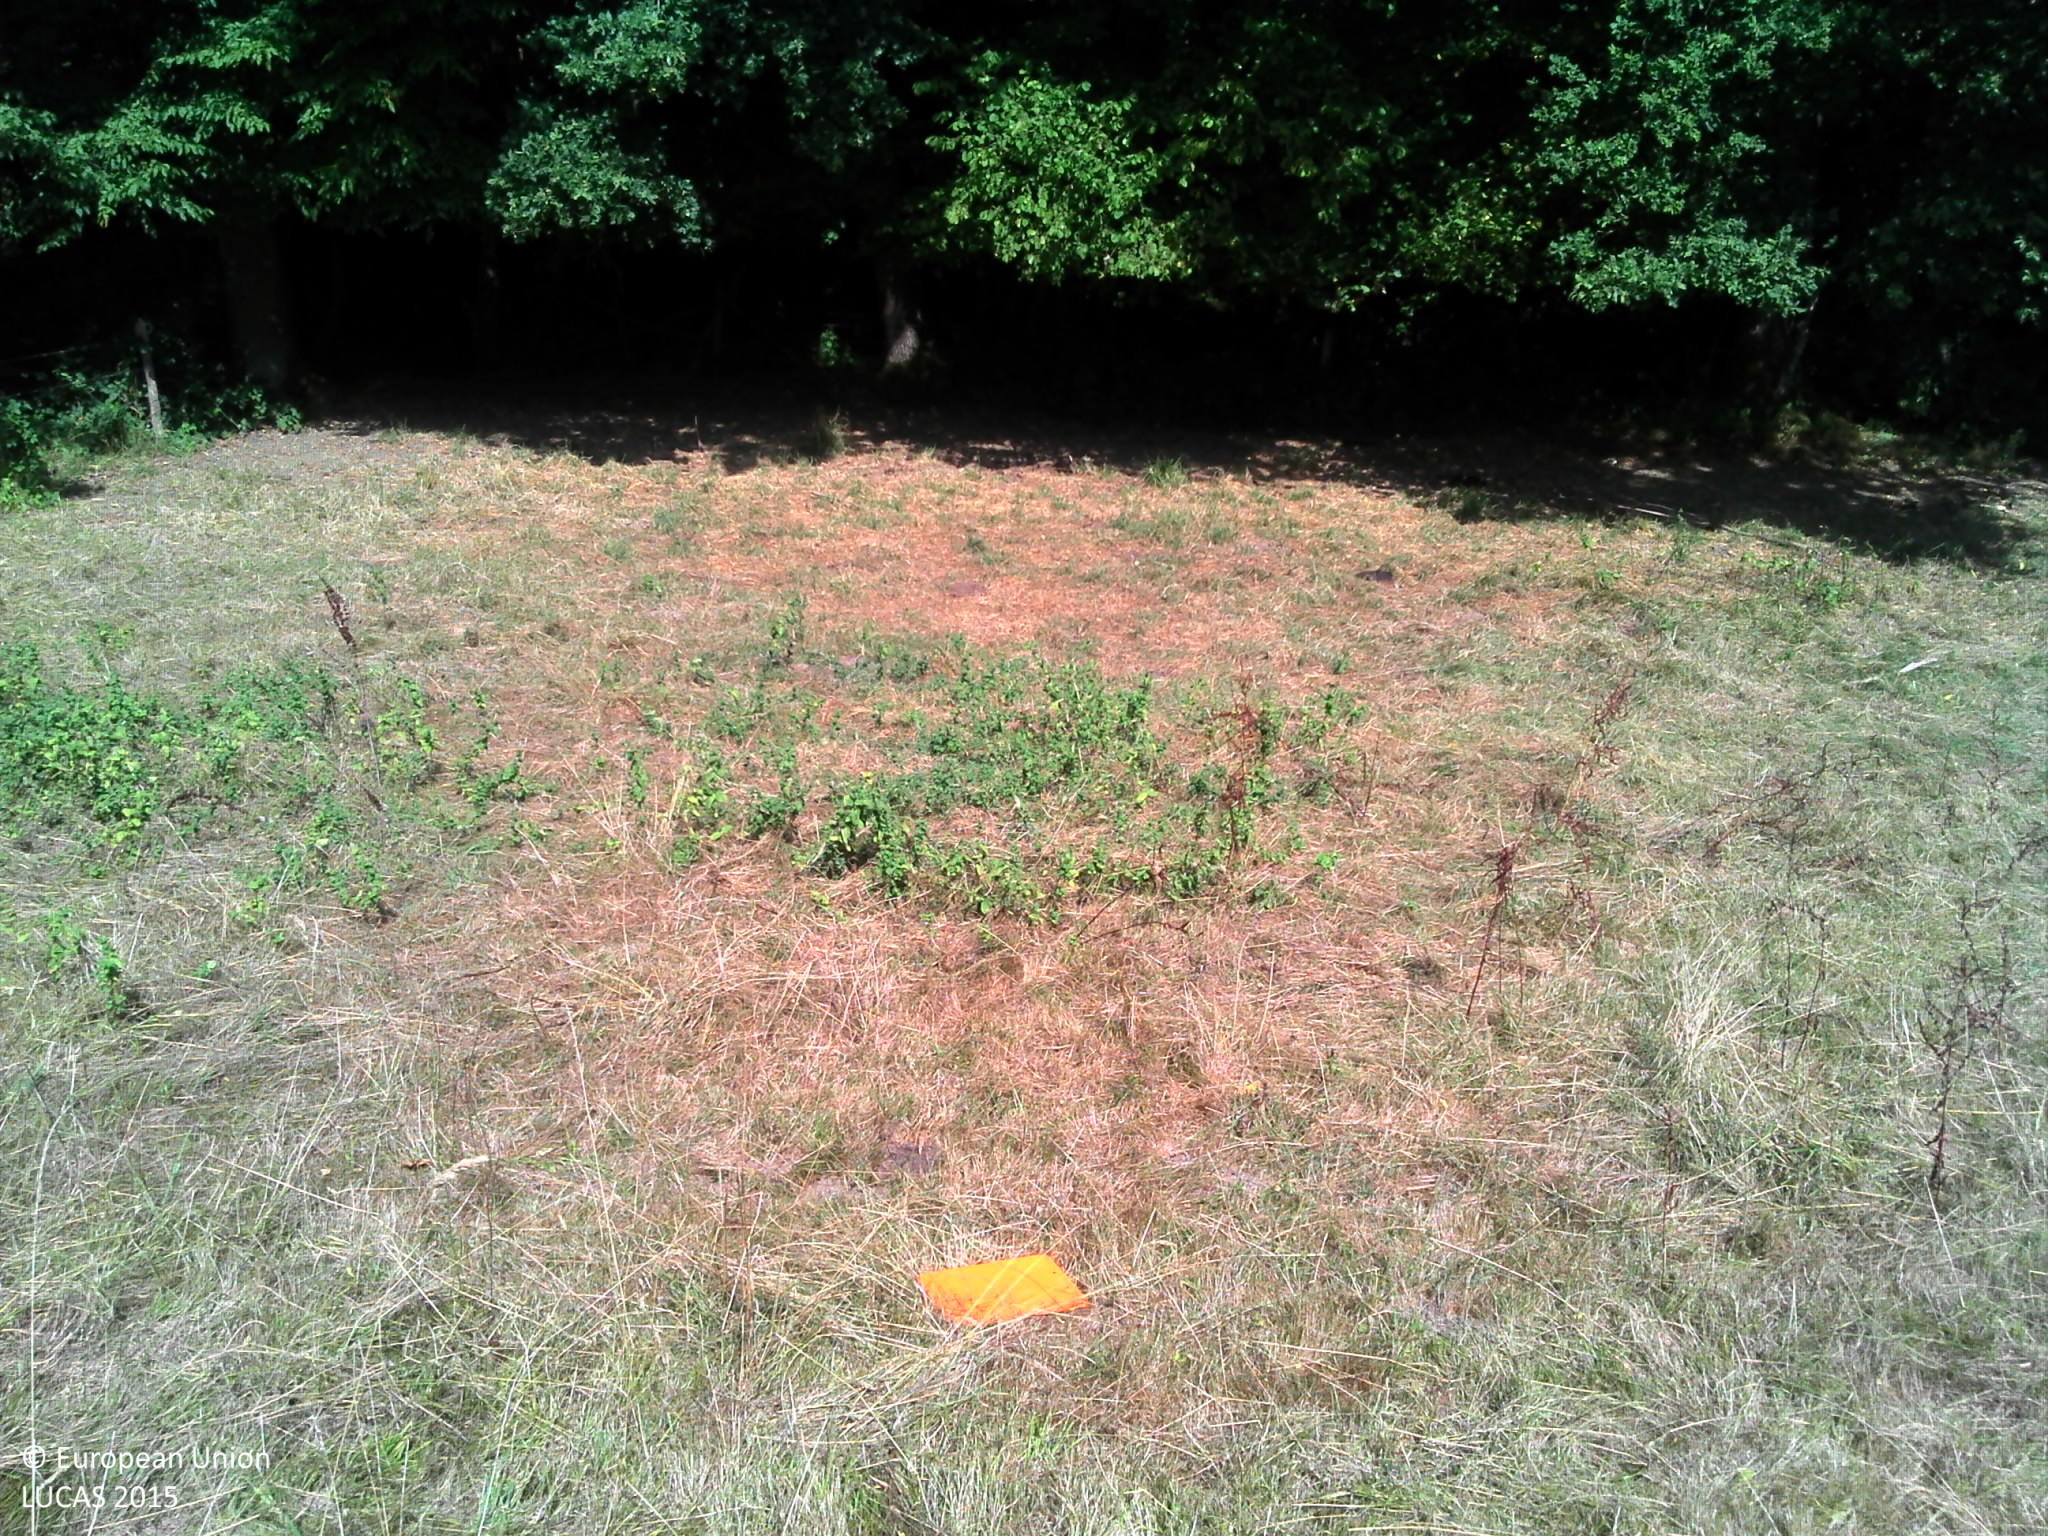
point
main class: Grassland
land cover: Grassland without tree/shrub cover
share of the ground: > 75 %
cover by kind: herbaceous plants 100 %
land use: Agriculture (excluding fallow land and kitchen gardens)
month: August
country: FR
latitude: 45.3987
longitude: 1.0876
